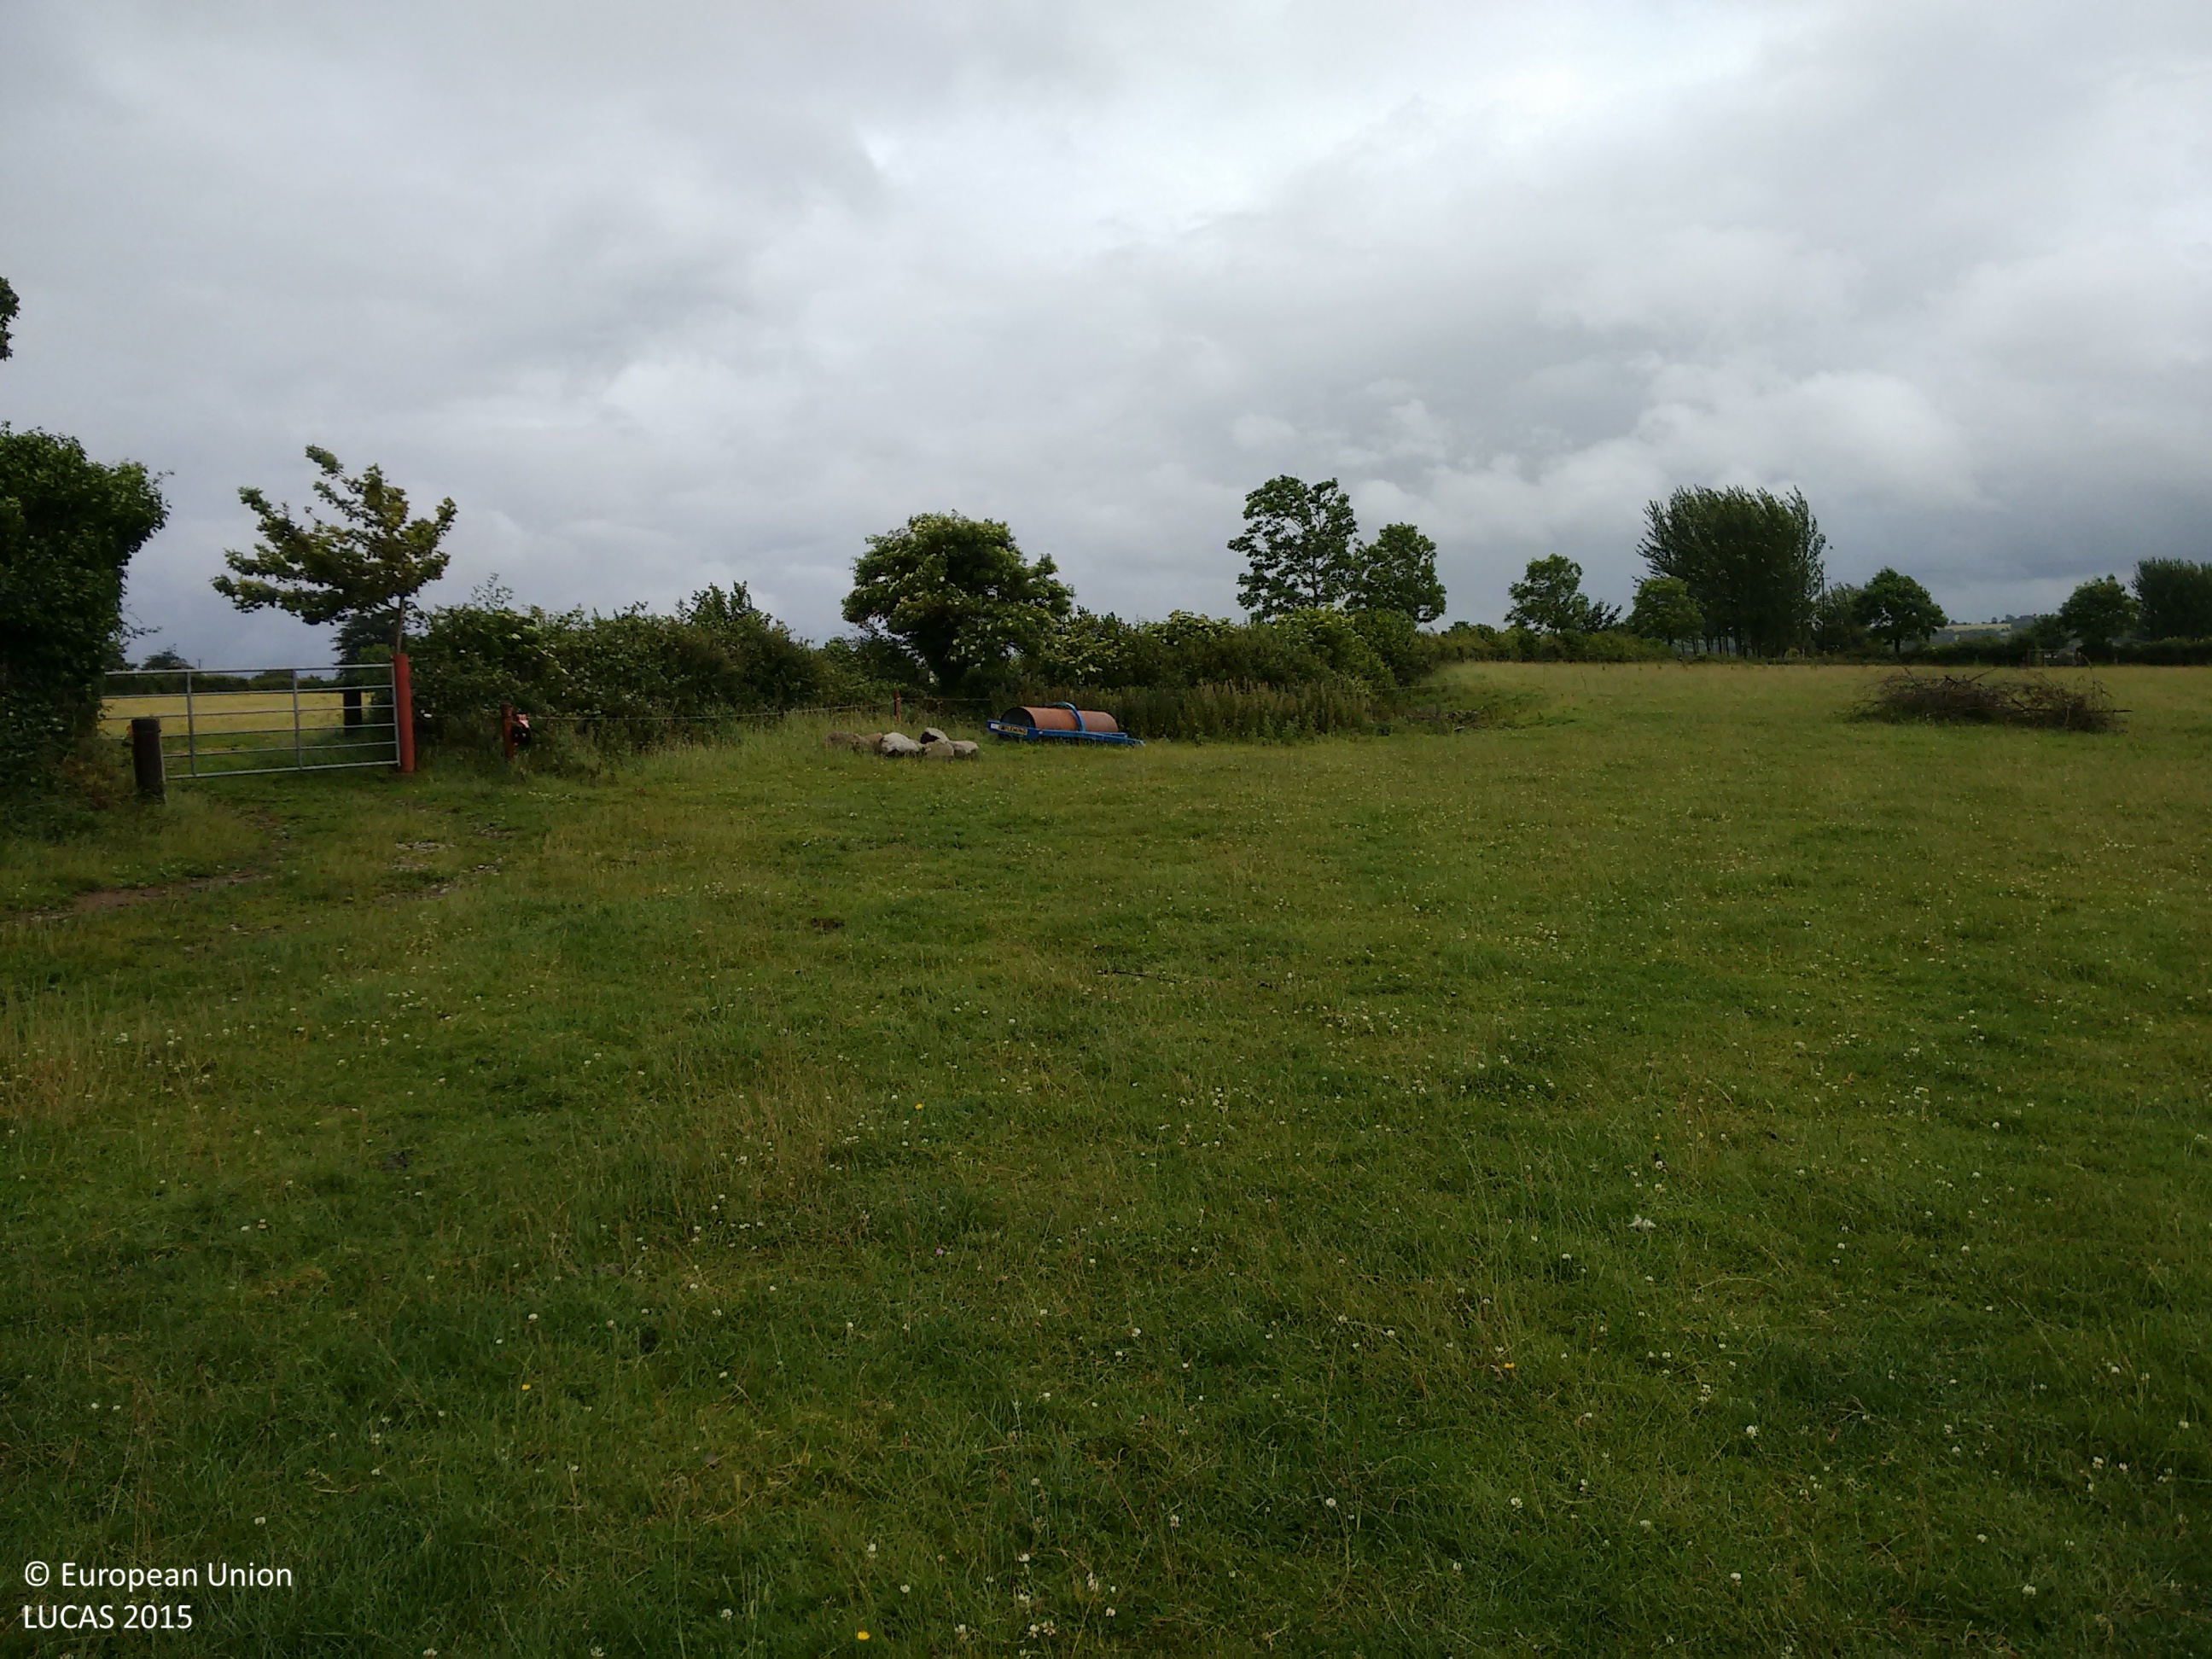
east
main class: Grassland
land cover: Grassland without tree/shrub cover
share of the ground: > 75 %
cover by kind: herbaceous plants 100 %
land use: Agriculture (excluding fallow land and kitchen gardens)
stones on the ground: < 10 %
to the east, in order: Grassland without tree/shrub cover; Fences; Broadleaved woodland; Fences; Grassland without tree/shrub cover; Electric lines; Grassland without tree/shrub cover; Fences; Abandoned hedges; Fences; Grassland without tree/shrub cover
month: July
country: IE
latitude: 53.6536
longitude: -8.0453
